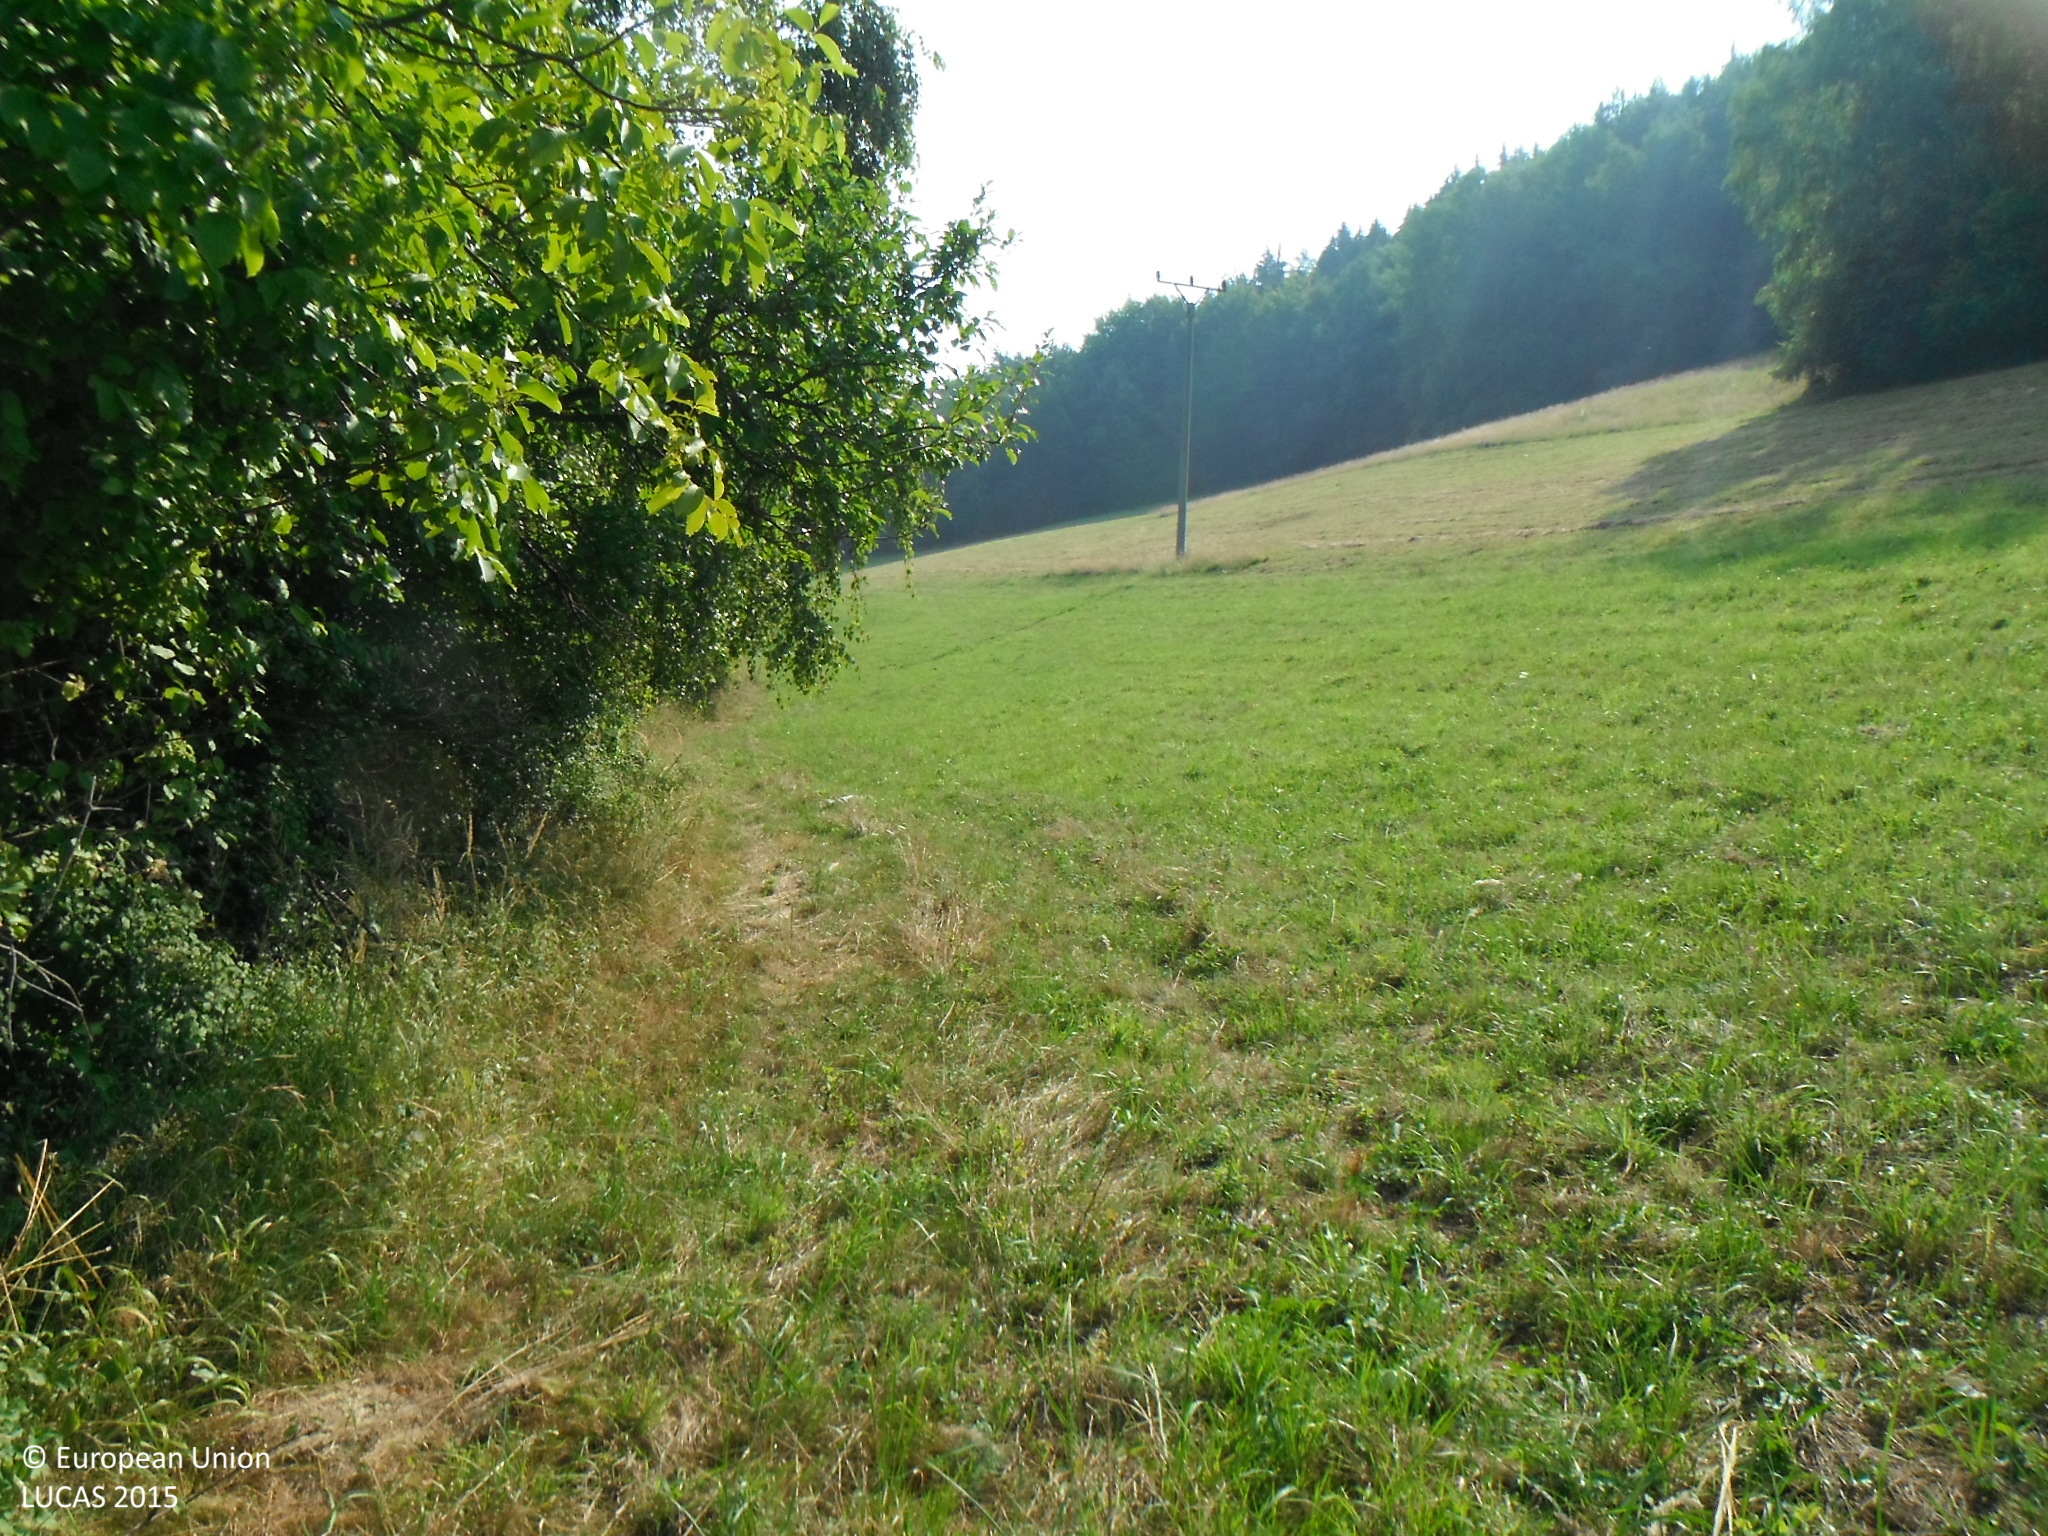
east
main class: Grassland
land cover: Grassland without tree/shrub cover
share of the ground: > 75 %
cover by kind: herbaceous plants 100 %
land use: Agriculture (excluding fallow land and kitchen gardens)
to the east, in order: Grassland without tree/shrub cover; Electric lines; Grassland without tree/shrub cover; Pine dominated mixed woodland
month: August
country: SK
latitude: 49.1332
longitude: 18.3913
